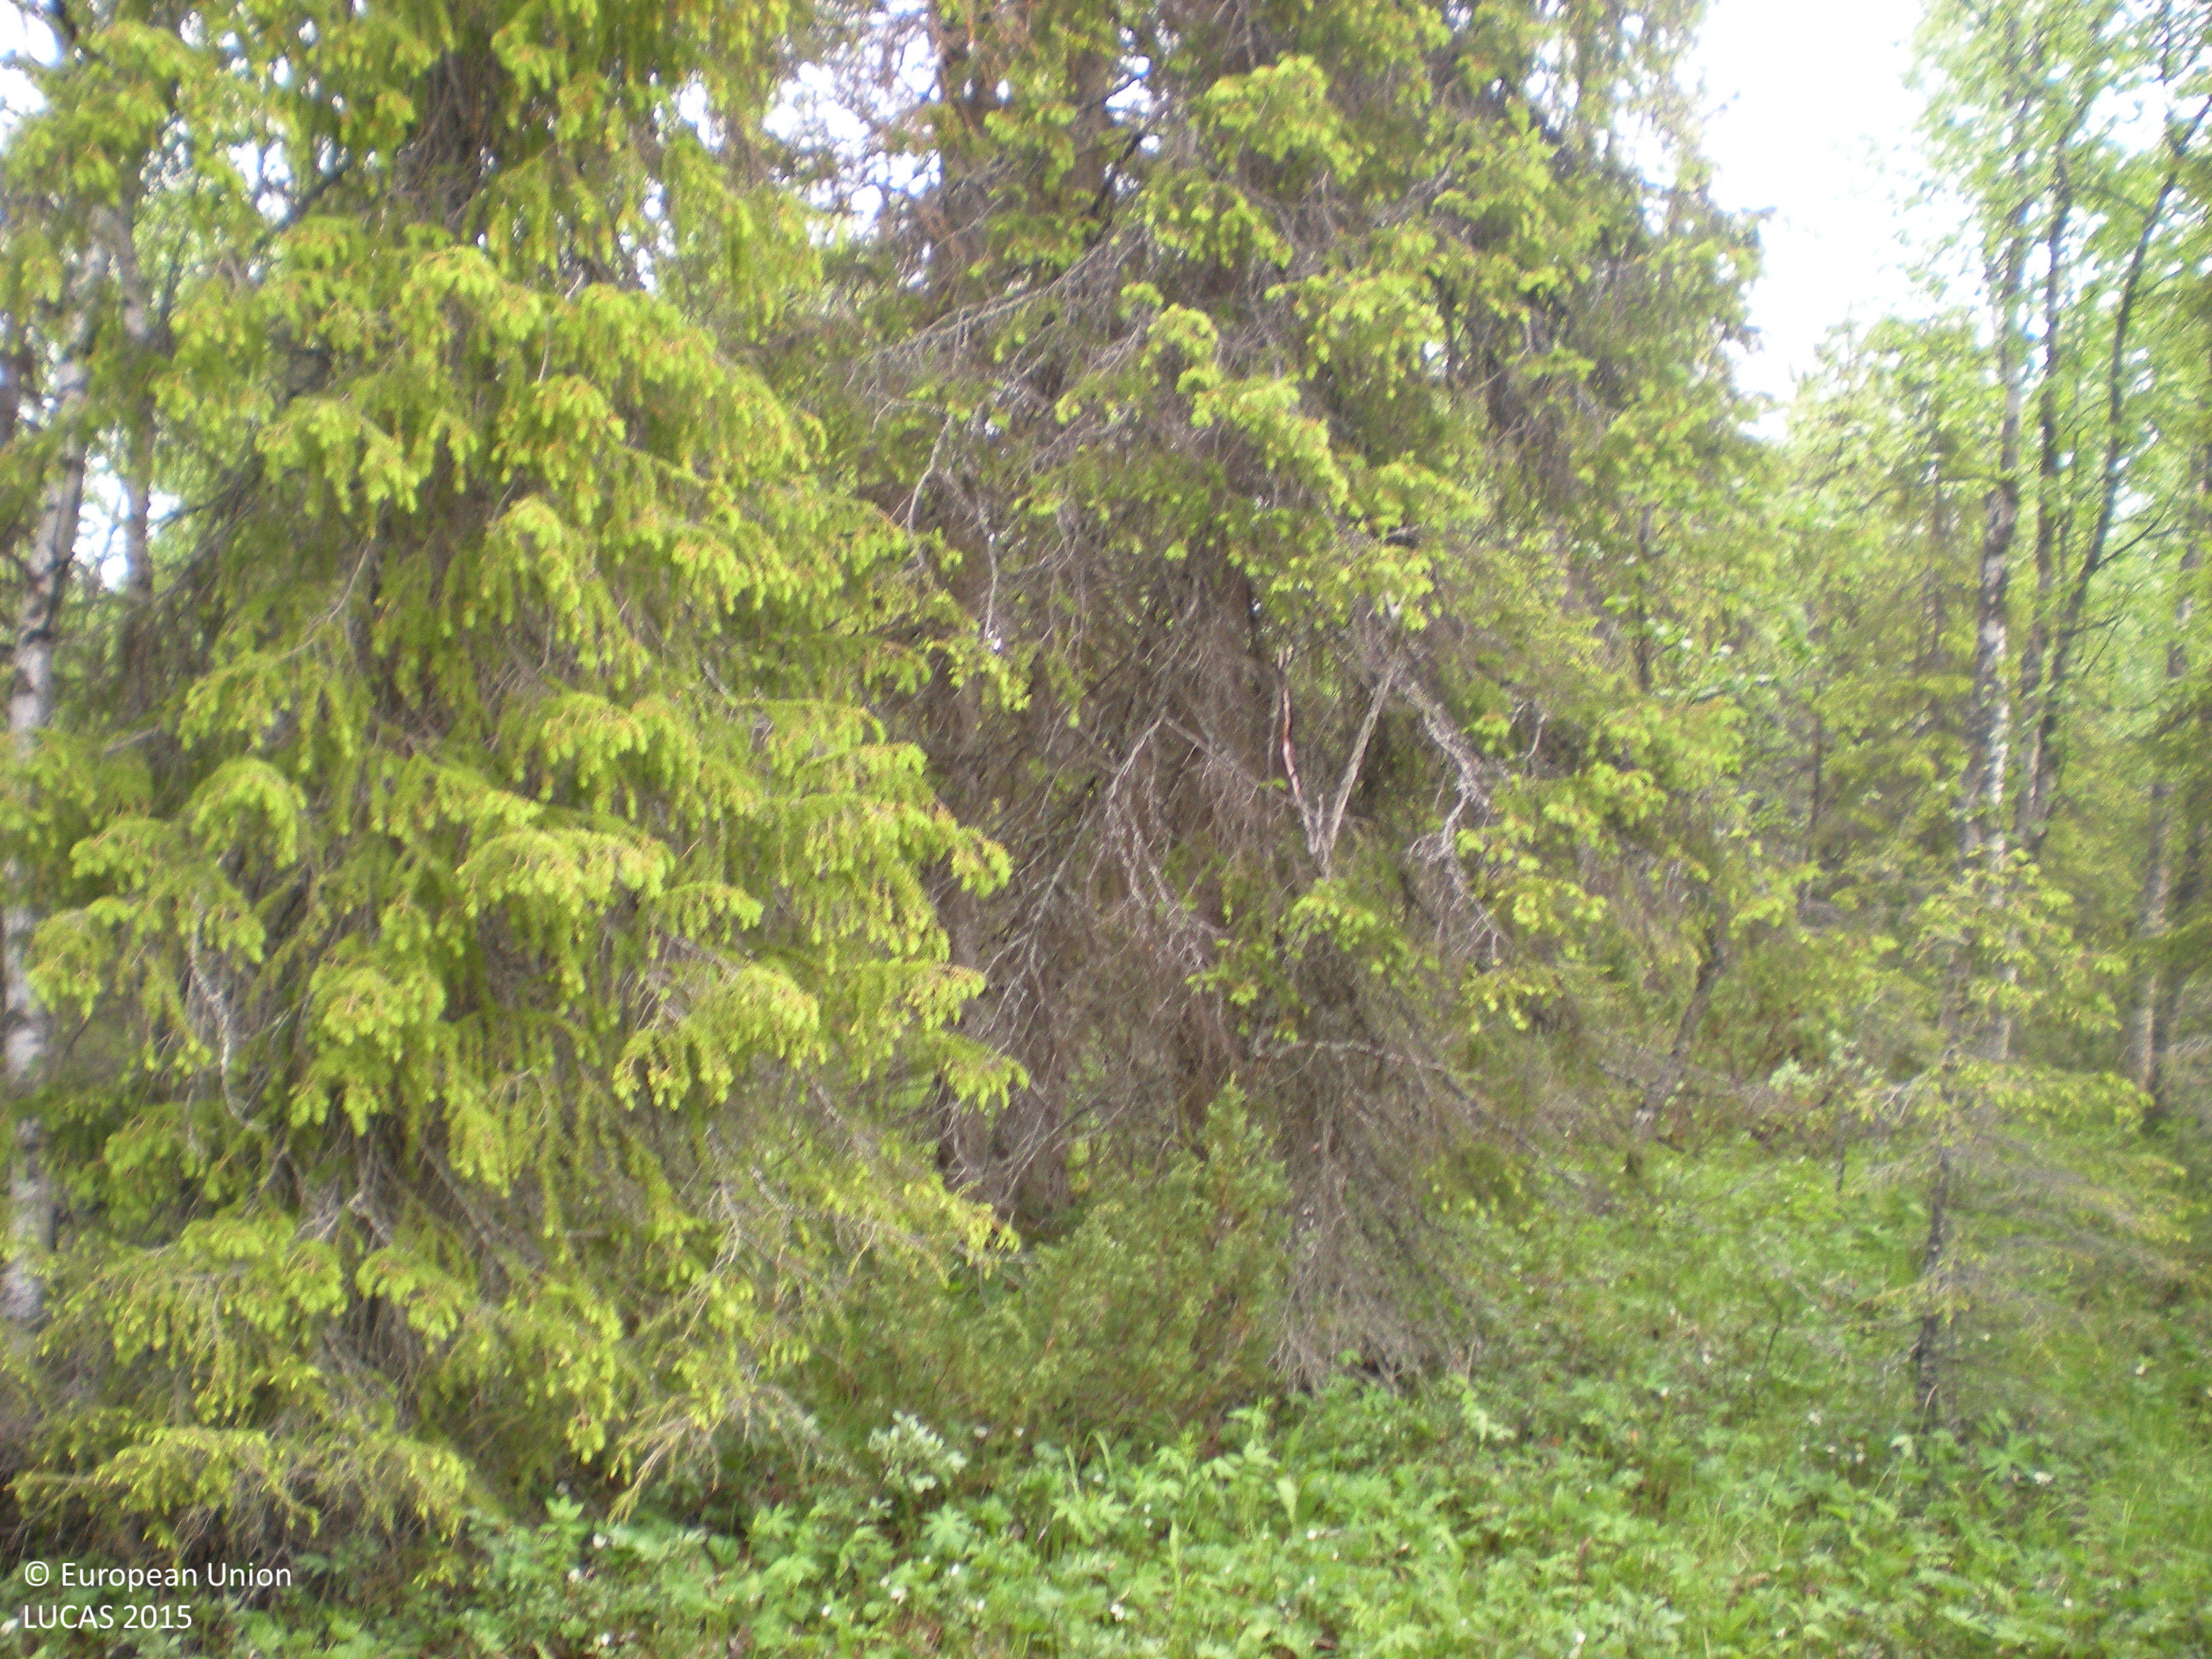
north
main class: Woodland
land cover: Spruce dominated mixed woodland
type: boreal forest
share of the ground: 50 - 75 %
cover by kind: coniferous forest trees 50 %, broadleaved forest trees 20 %, shrubs 15 %, herbaceous plants 10 %, lichens and mosses 5 %
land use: Forestry
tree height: > 5 m
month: July
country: SE
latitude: 66.0874
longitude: 17.1854
